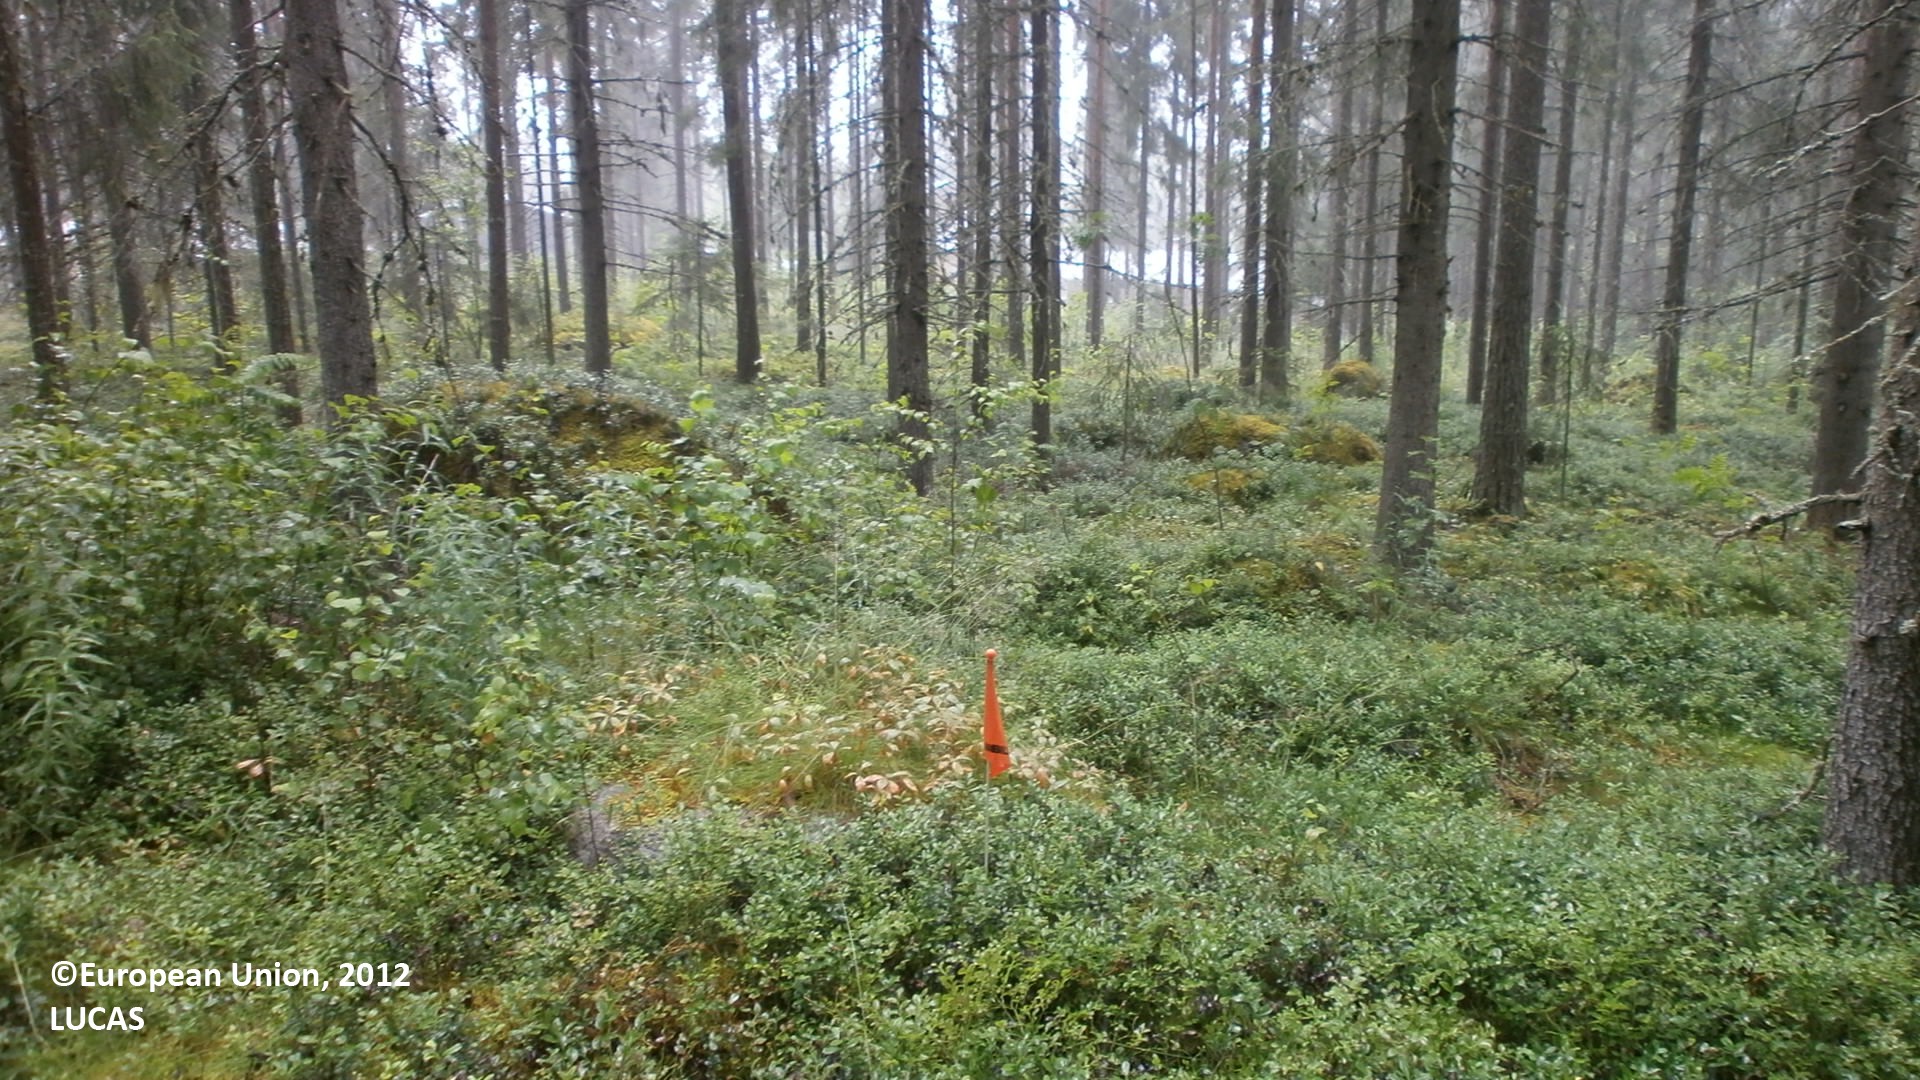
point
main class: Woodland
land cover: Spruce dominated coniferous woodland
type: boreal forest
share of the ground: 50 - 75 %
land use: Forestry
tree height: > 5 m
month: July
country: FI
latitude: 64.0874
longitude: 23.7819
